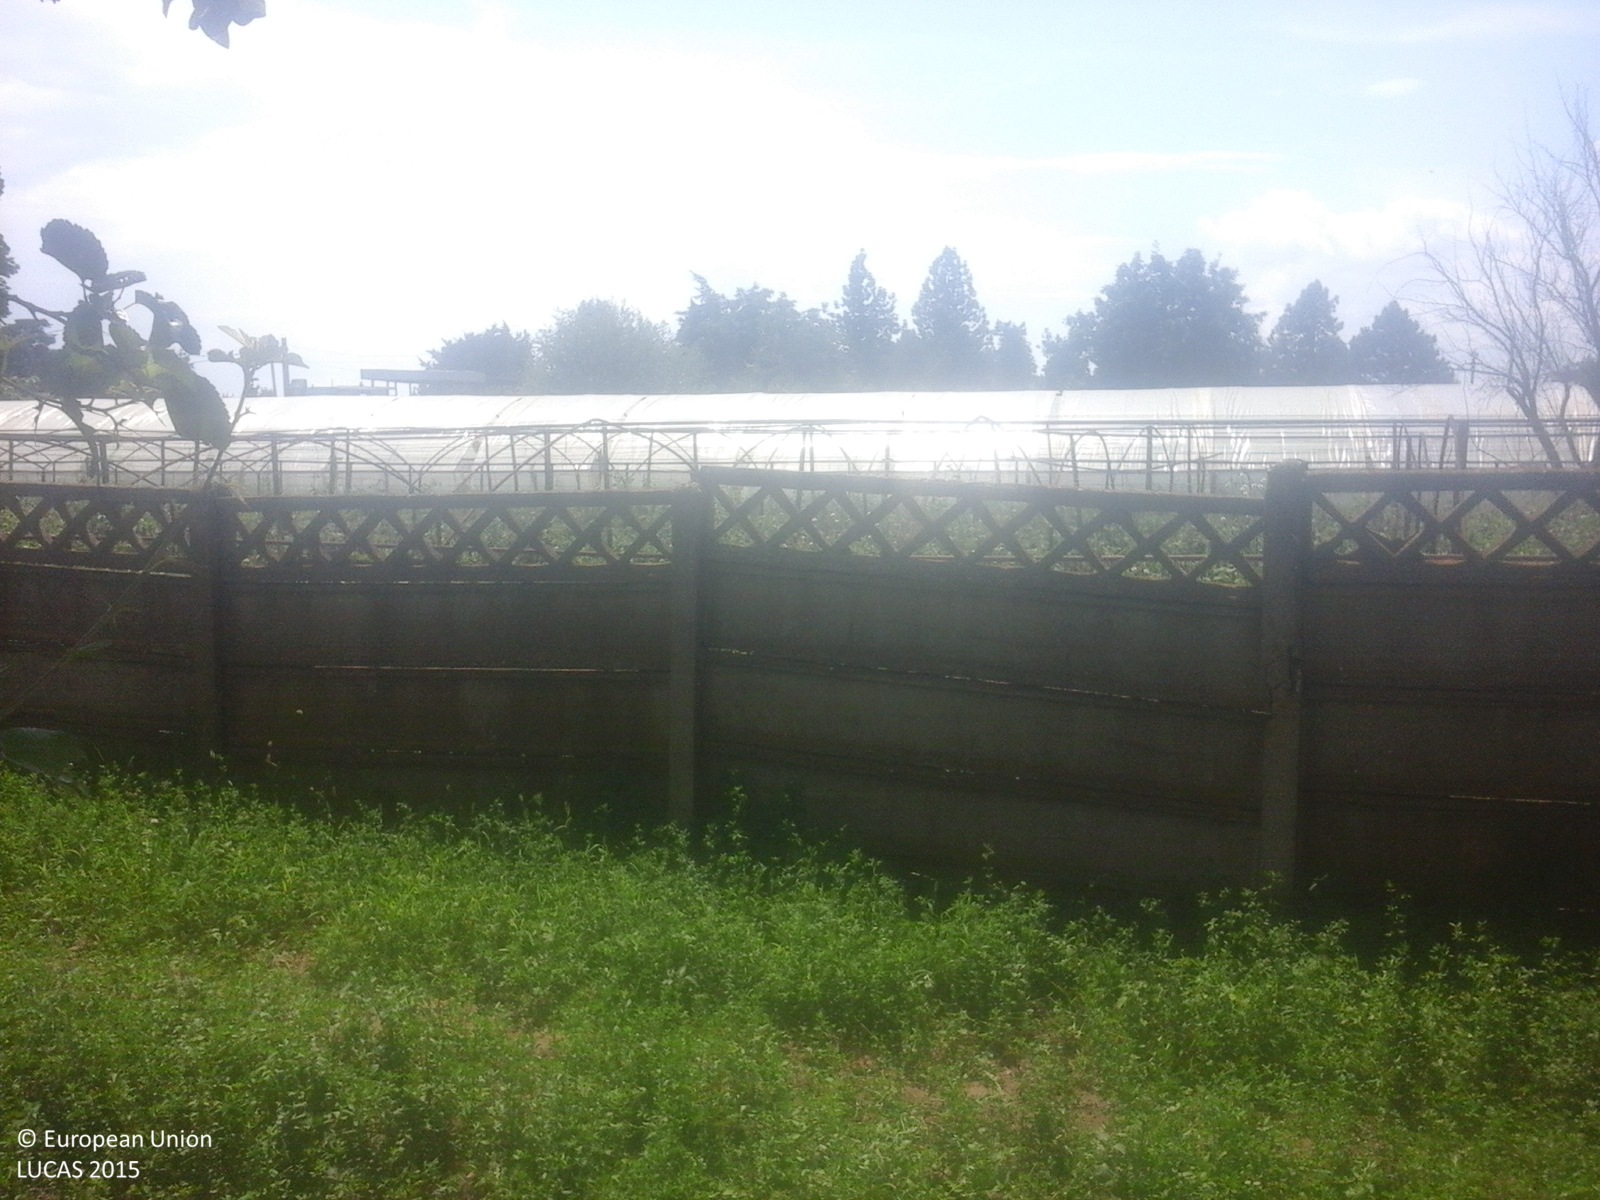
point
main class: Artificial land
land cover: Greenhouses
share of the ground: > 75 %
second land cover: Tomatoes
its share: > 75 %
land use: Agriculture (excluding fallow land and kitchen gardens)
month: July
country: RO
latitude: 43.8167
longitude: 24.6511
